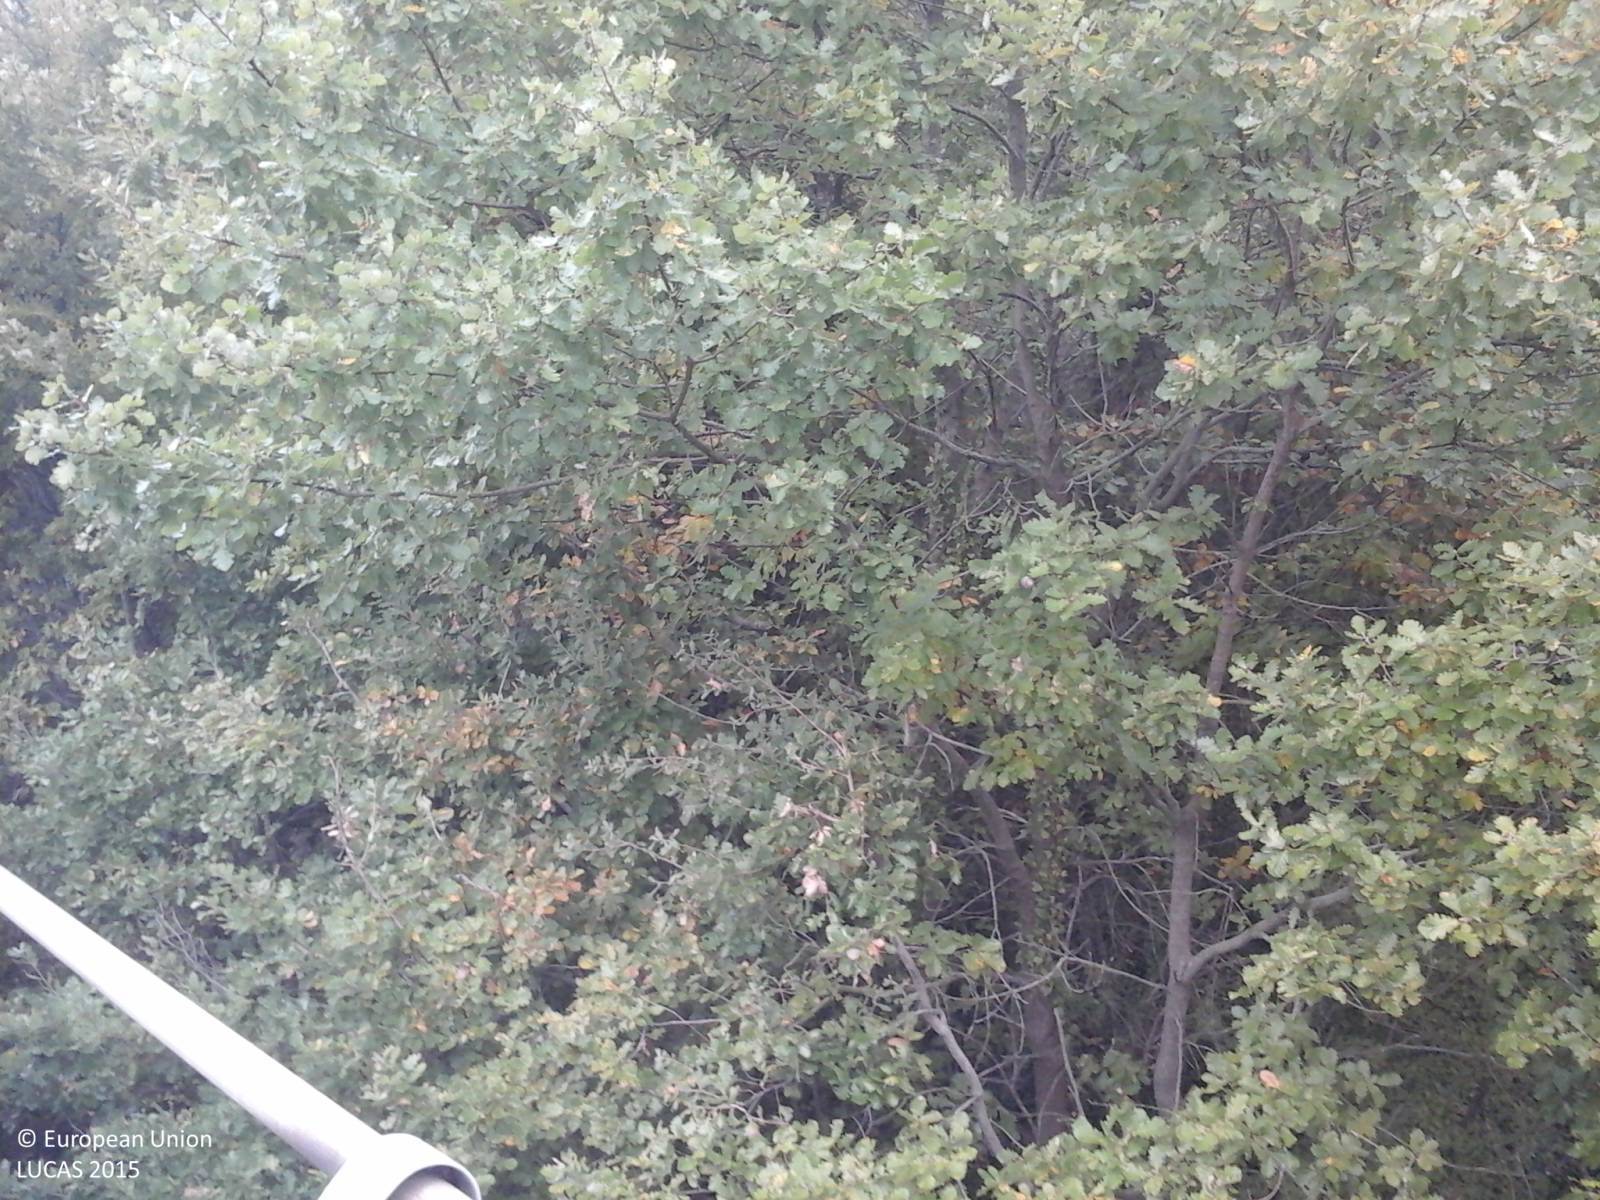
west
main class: Woodland
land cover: Broadleaved woodland
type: thermophilous deciduous forest
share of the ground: > 75 %
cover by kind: broadleaved forest trees 100 %
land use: Forestry
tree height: > 5 m
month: October
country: IT
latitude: 42.7888
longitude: 12.3765
